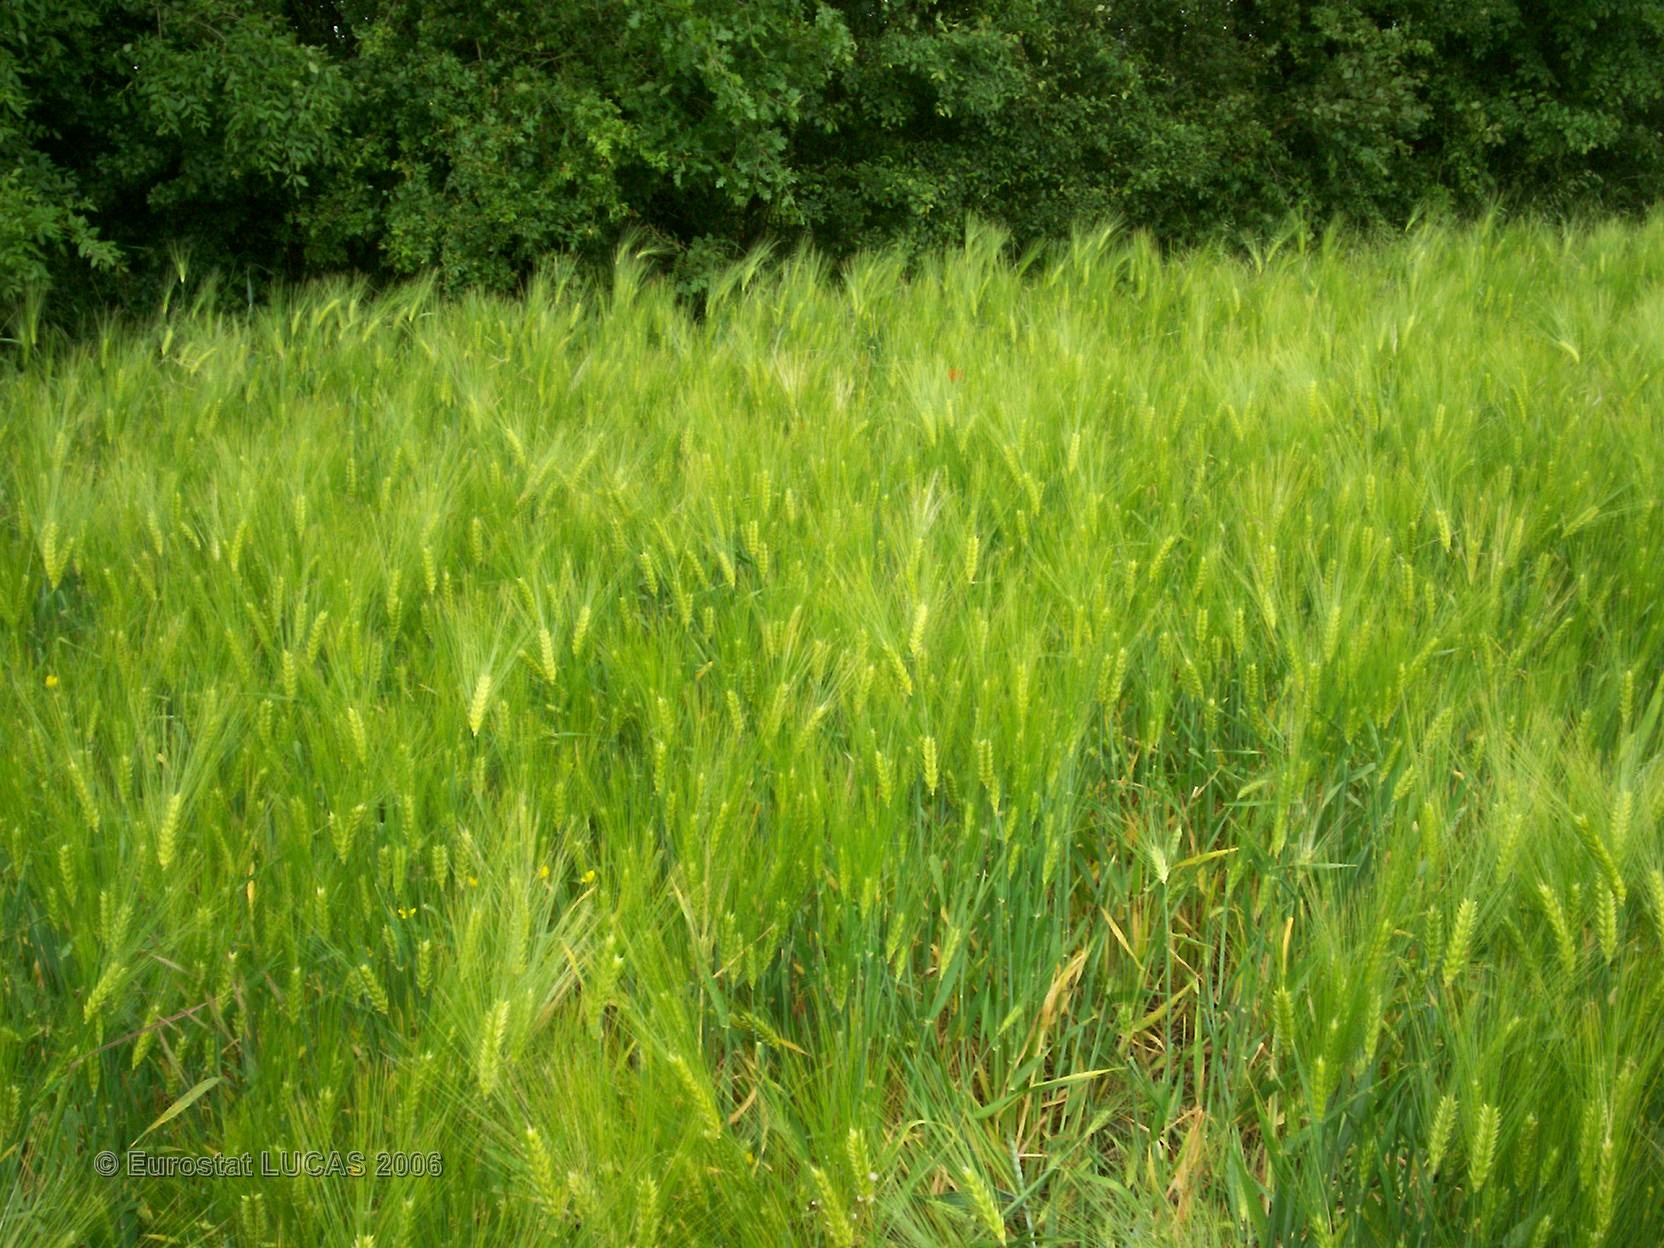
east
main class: Cropland
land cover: Barley
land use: Agriculture (excluding fallow land and kitchen gardens)
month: May
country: FR
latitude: 46.2919
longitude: 0.5206
